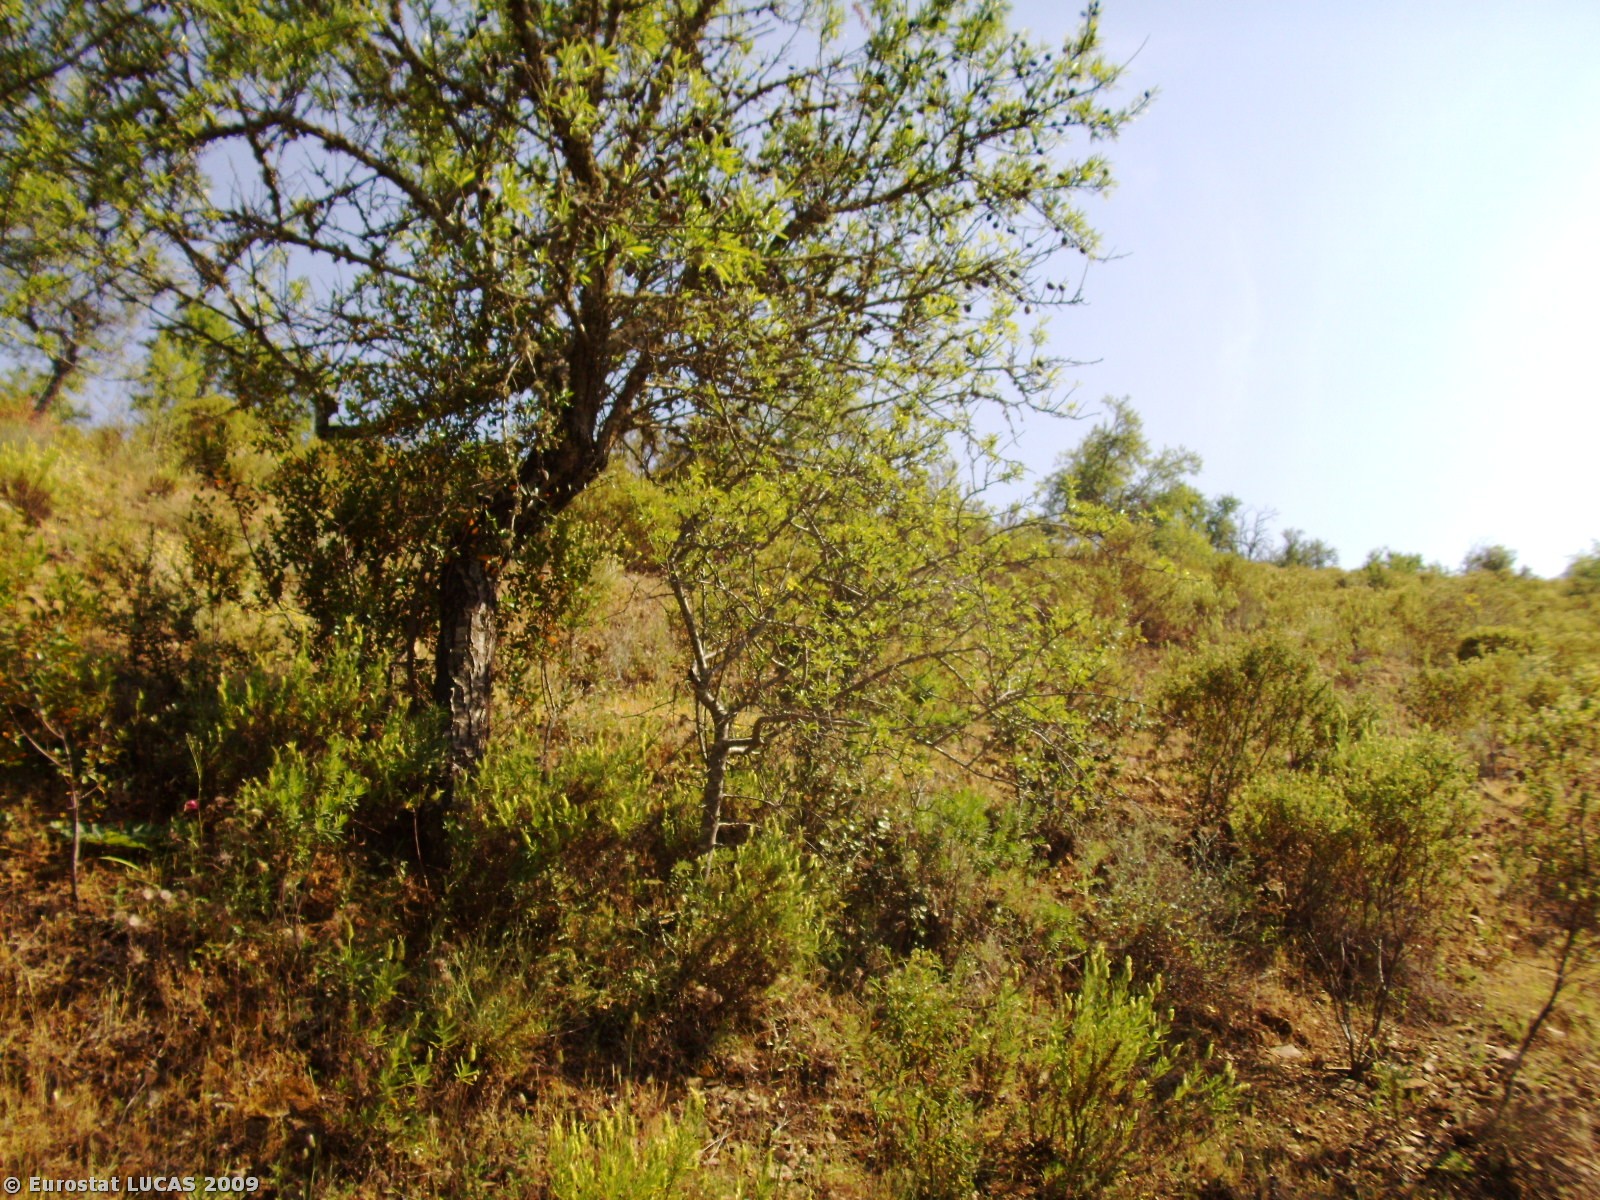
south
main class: Cropland
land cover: Nuts trees
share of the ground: < 10 %
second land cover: Spontaneously vegetated surfaces
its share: > 75 %
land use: Agriculture (excluding fallow land and kitchen gardens)
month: May
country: PT
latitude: 37.3910
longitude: -7.4801
